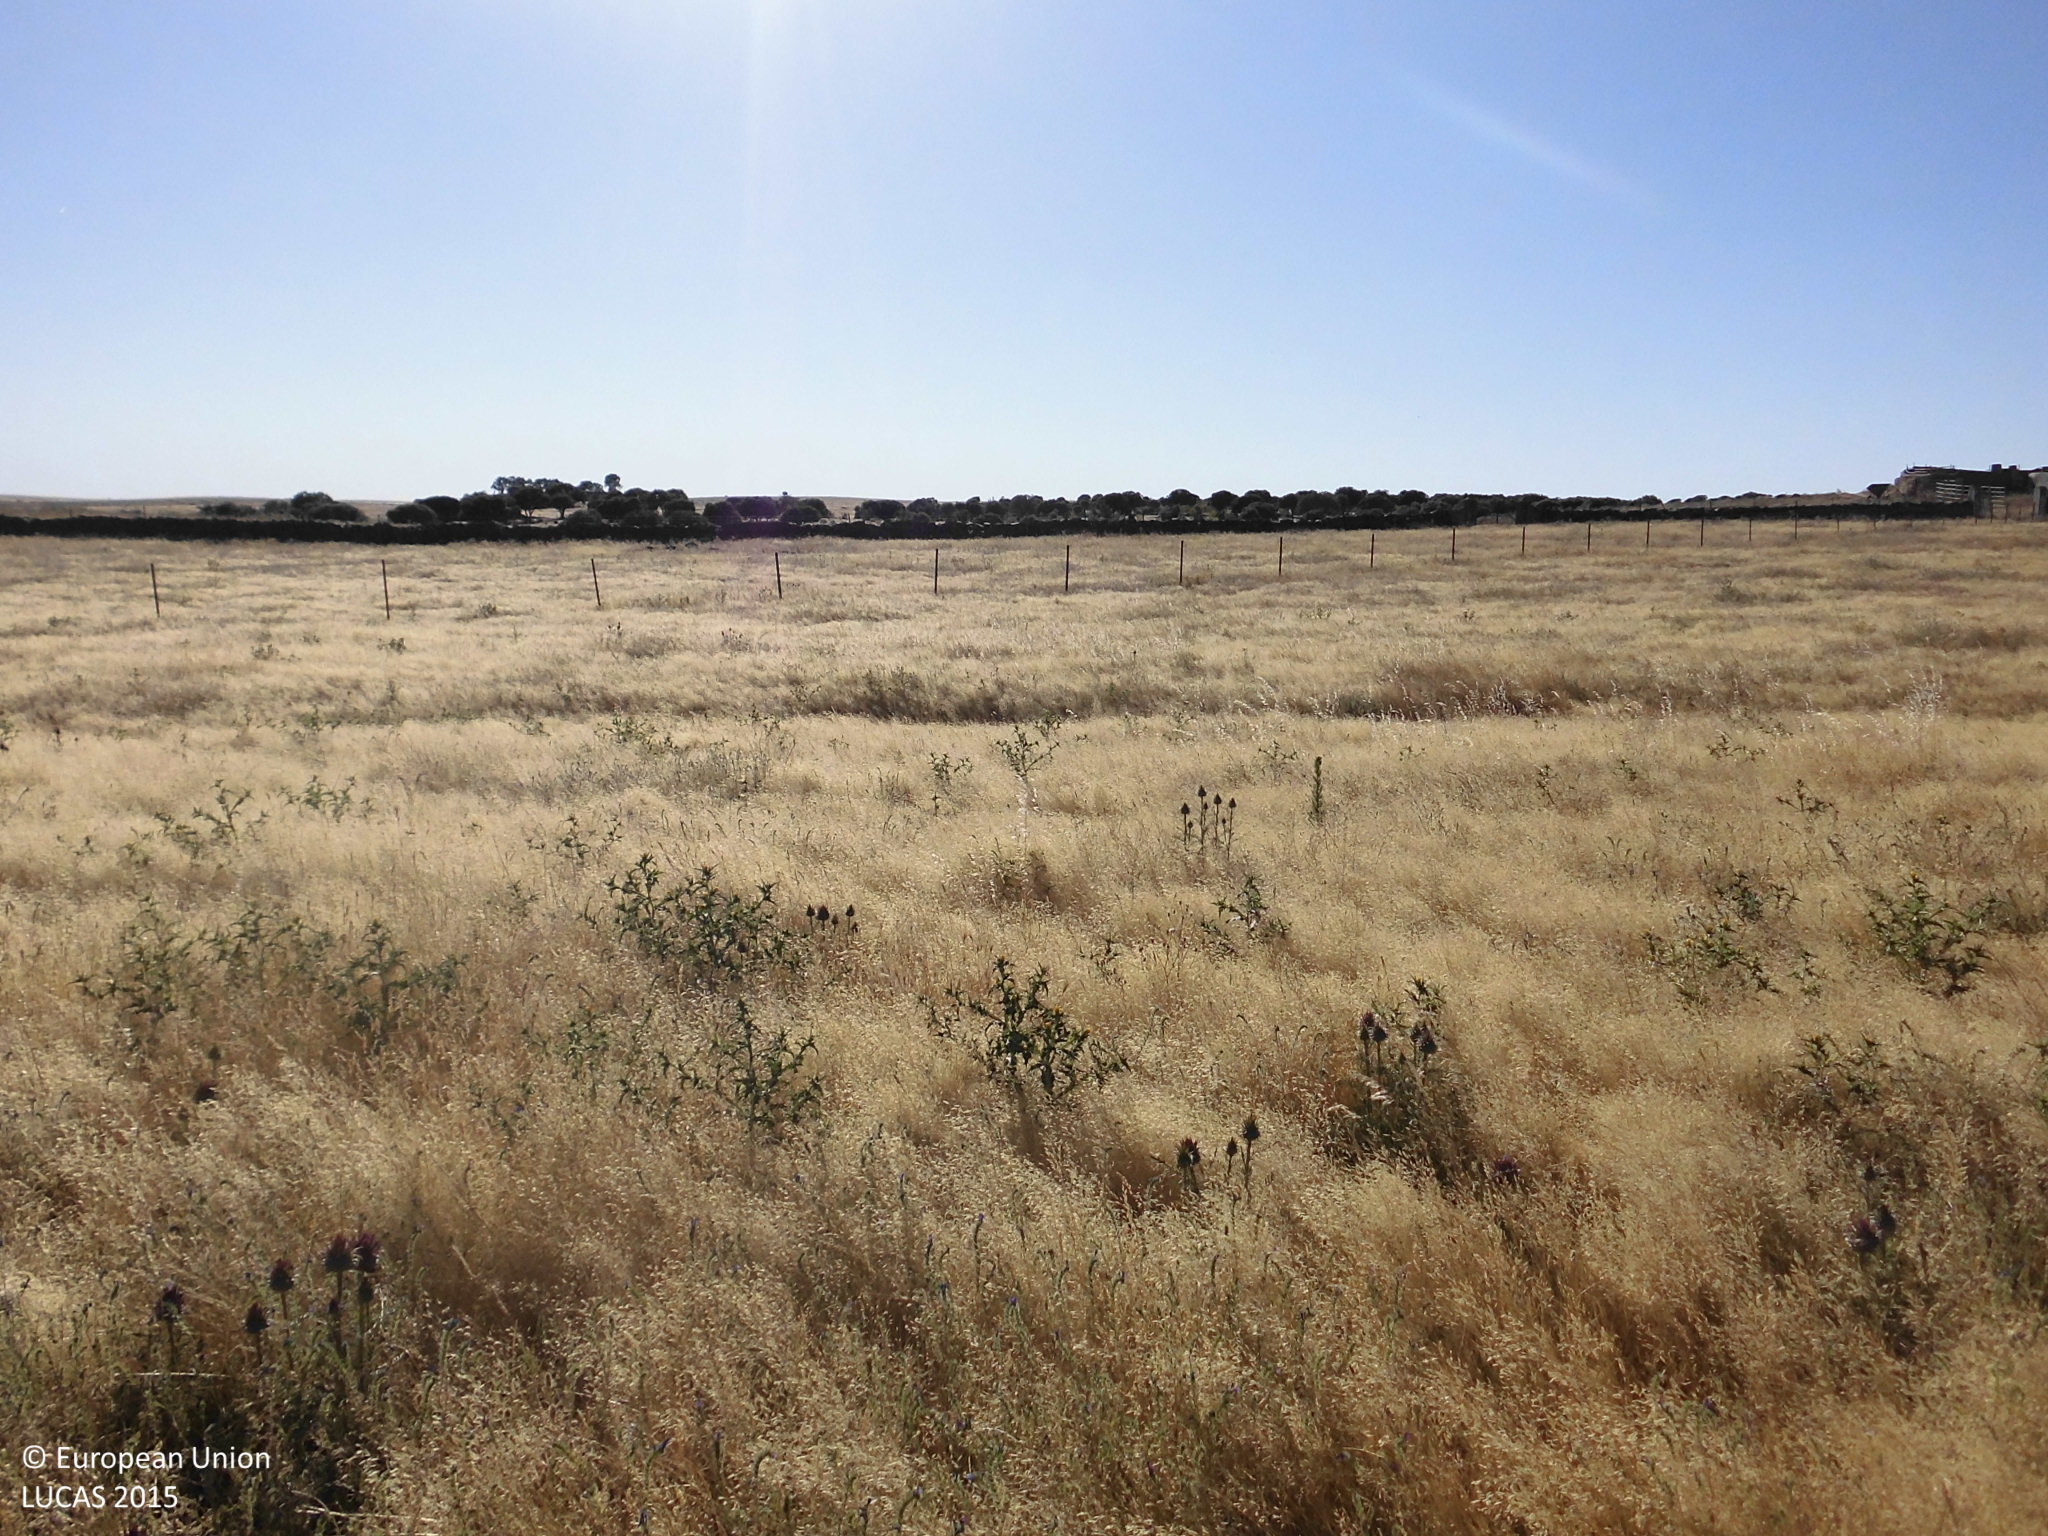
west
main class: Grassland
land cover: Grassland without tree/shrub cover
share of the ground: > 75 %
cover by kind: herbaceous plants 100 %
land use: Agriculture (excluding fallow land and kitchen gardens)
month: May
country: ES
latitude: 39.5466
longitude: -5.9212
